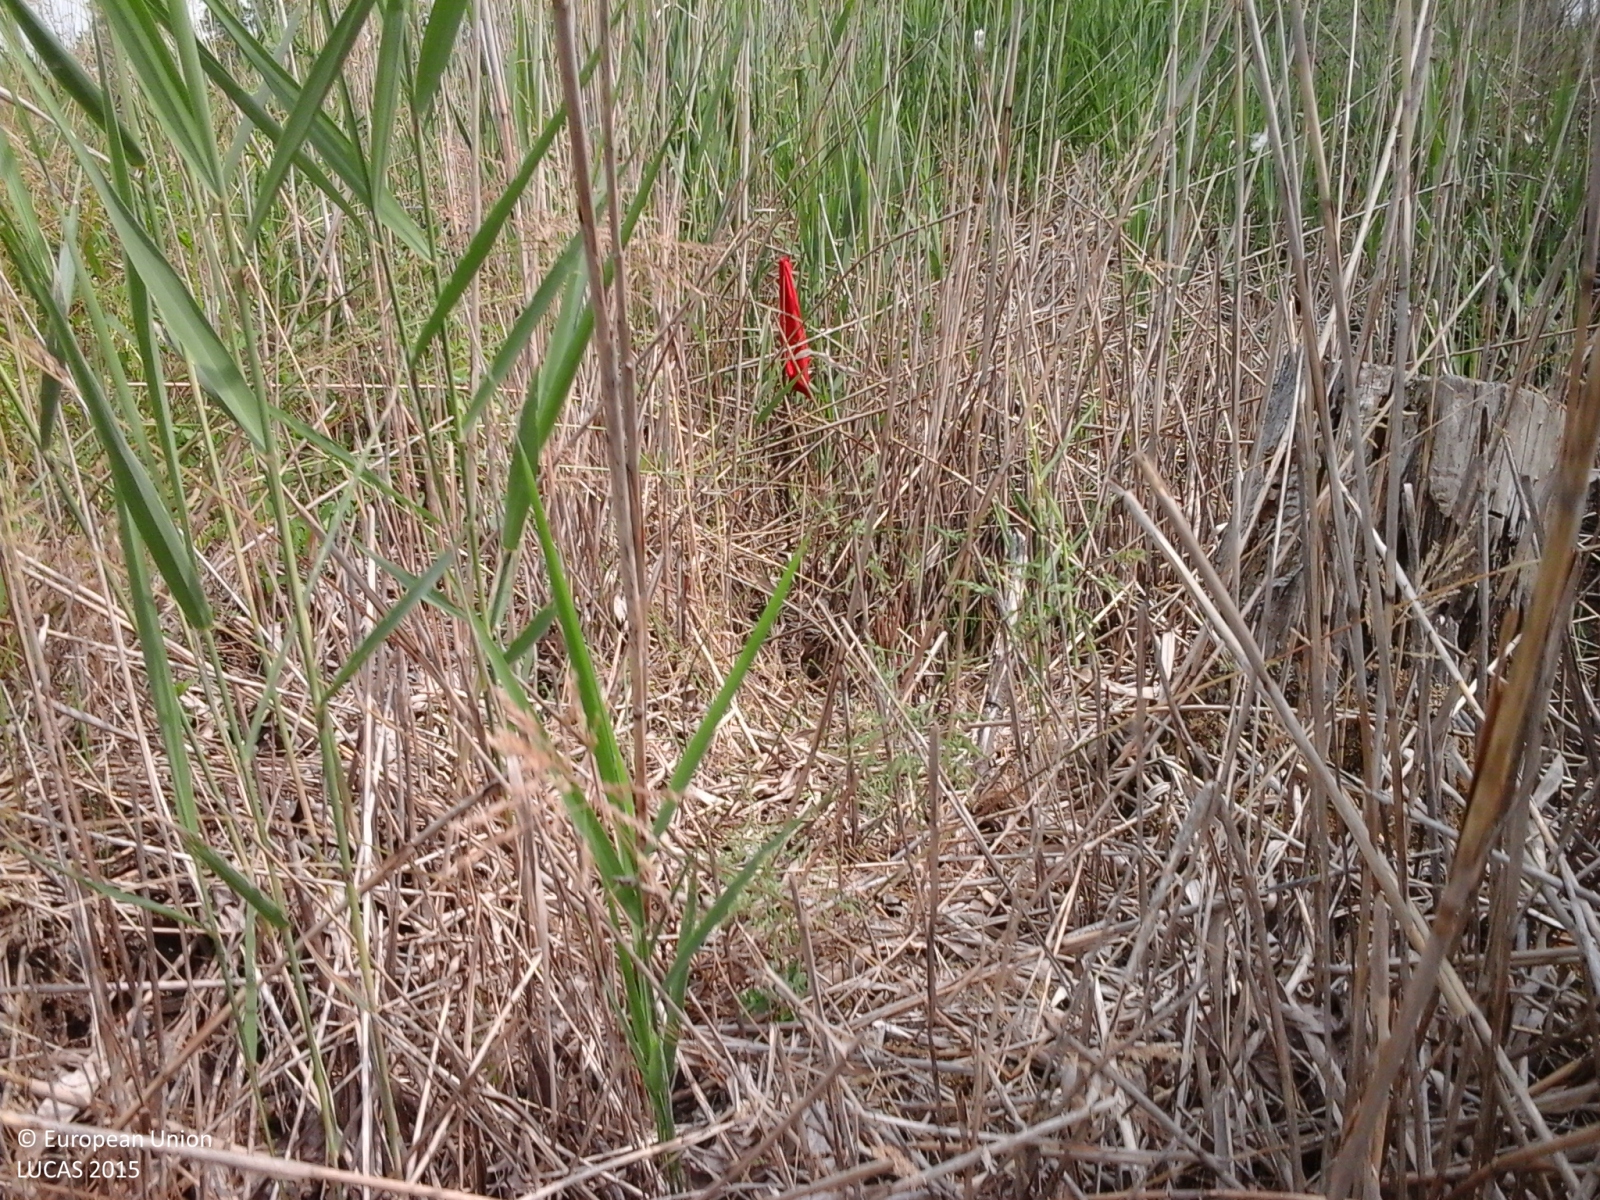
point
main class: Woodland
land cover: Broadleaved woodland
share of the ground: 50 - 75 %
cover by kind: broadleaved forest trees 60 %, shrubs 40 %
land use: Forestry
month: May
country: IT
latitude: 45.1875
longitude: 8.5136
